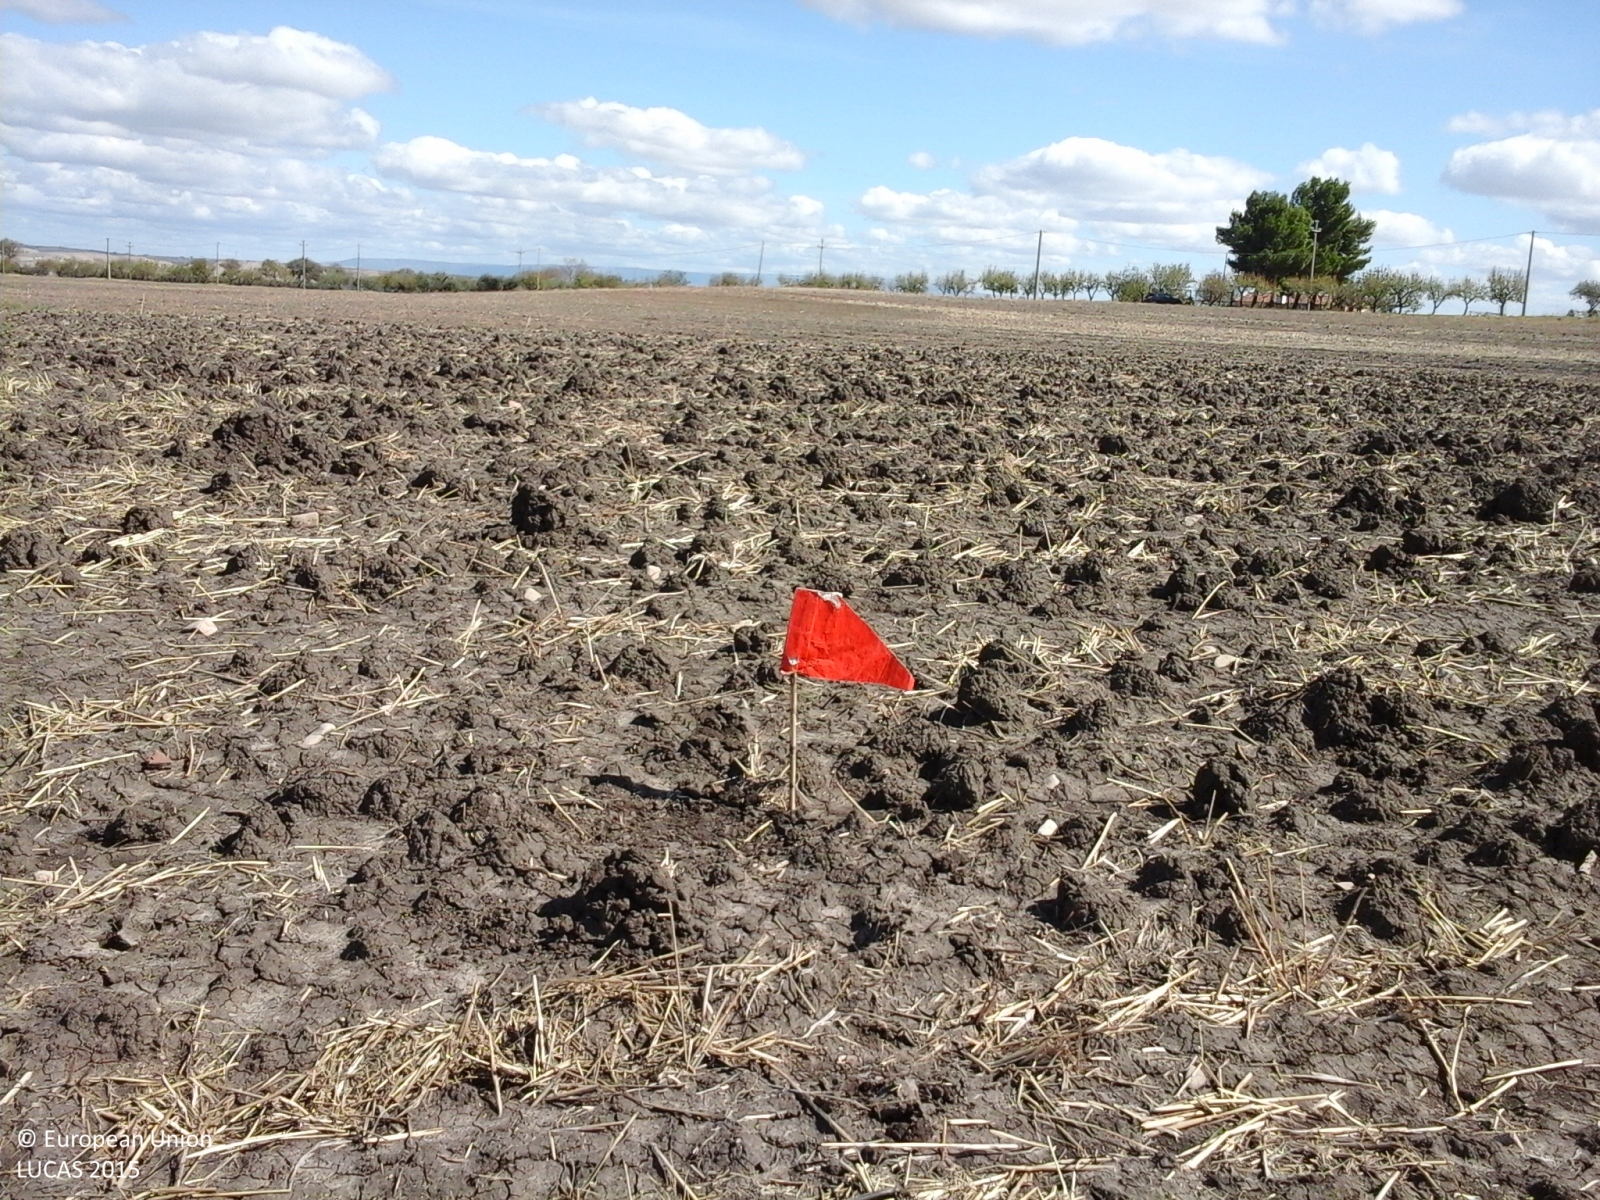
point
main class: Cropland
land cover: Durum wheat
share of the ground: > 75 %
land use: Agriculture (excluding fallow land and kitchen gardens)
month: September
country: IT
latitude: 41.6357
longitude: 15.1571
